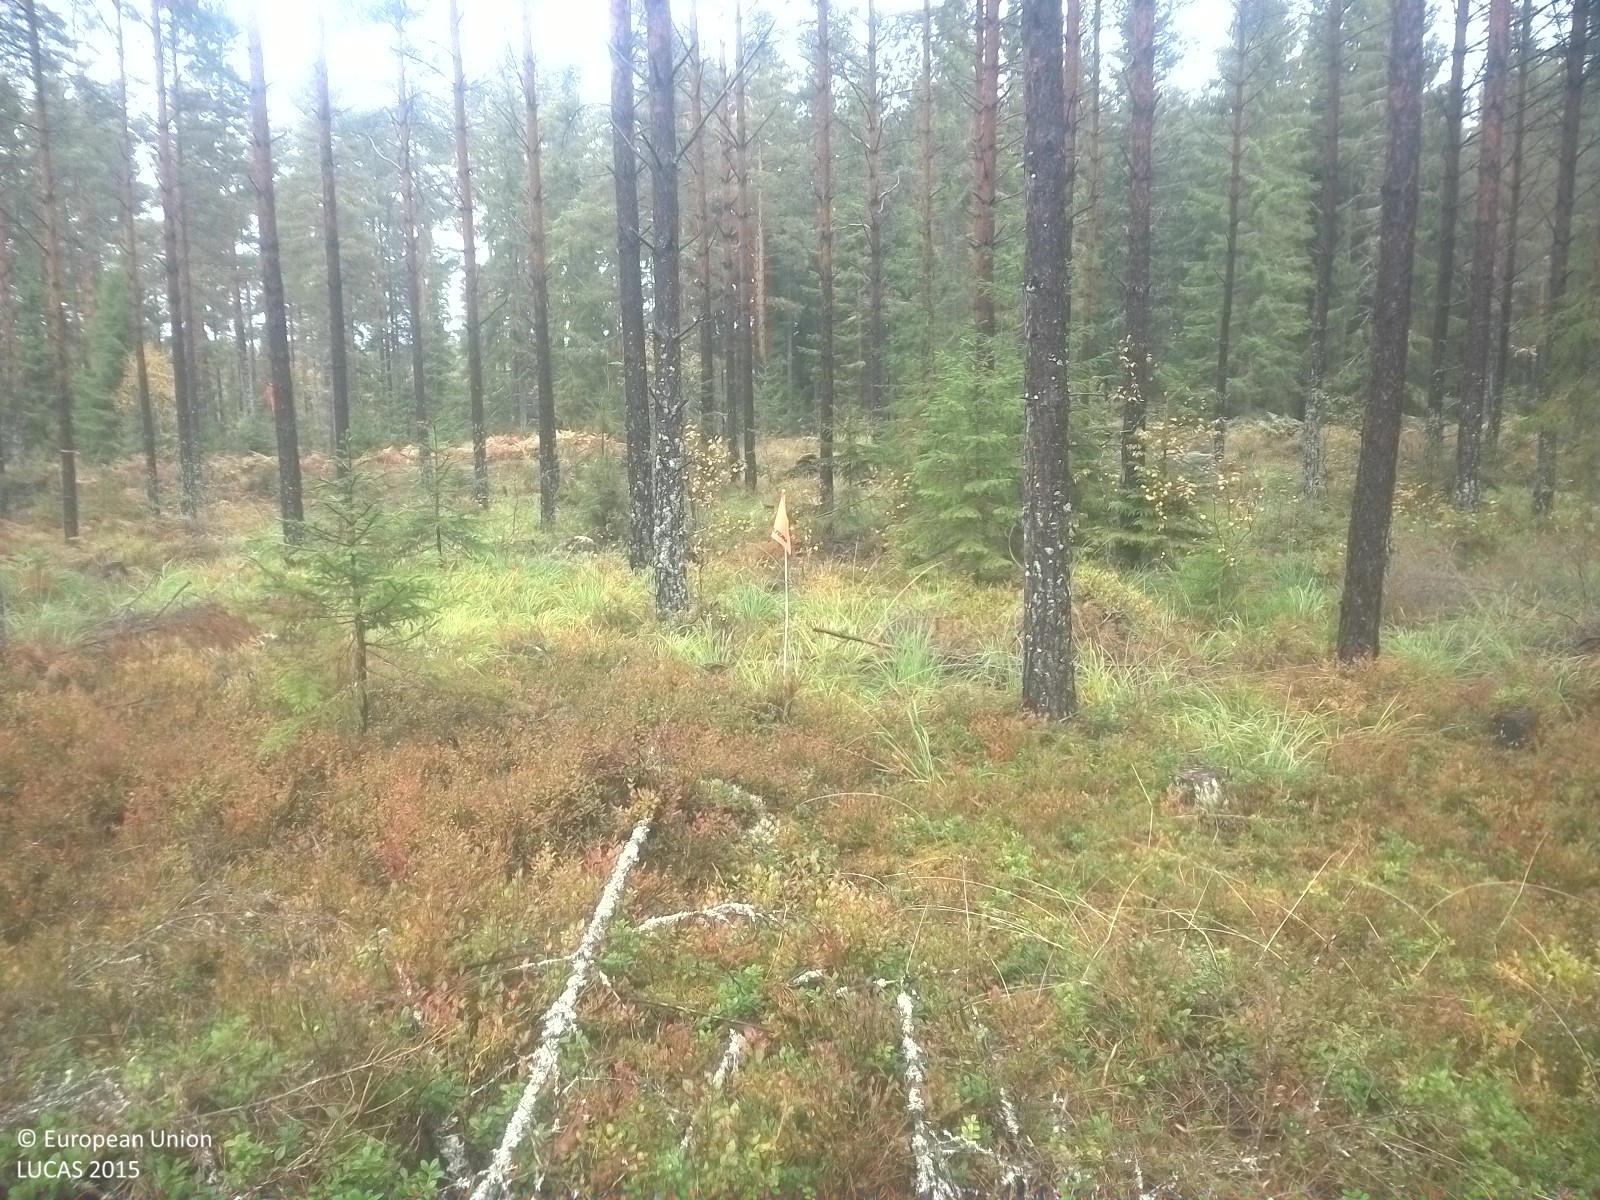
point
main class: Woodland
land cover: Pine dominated coniferous woodland
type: boreal forest
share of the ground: 25 - 50 %
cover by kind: herbaceous plants 50 %, coniferous forest trees 30 %, lichens and mosses 10 %, broadleaved forest trees 5 %, shrubs 5 %
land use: Forestry
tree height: > 5 m
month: September
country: SE
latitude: 58.8323
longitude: 16.2481
